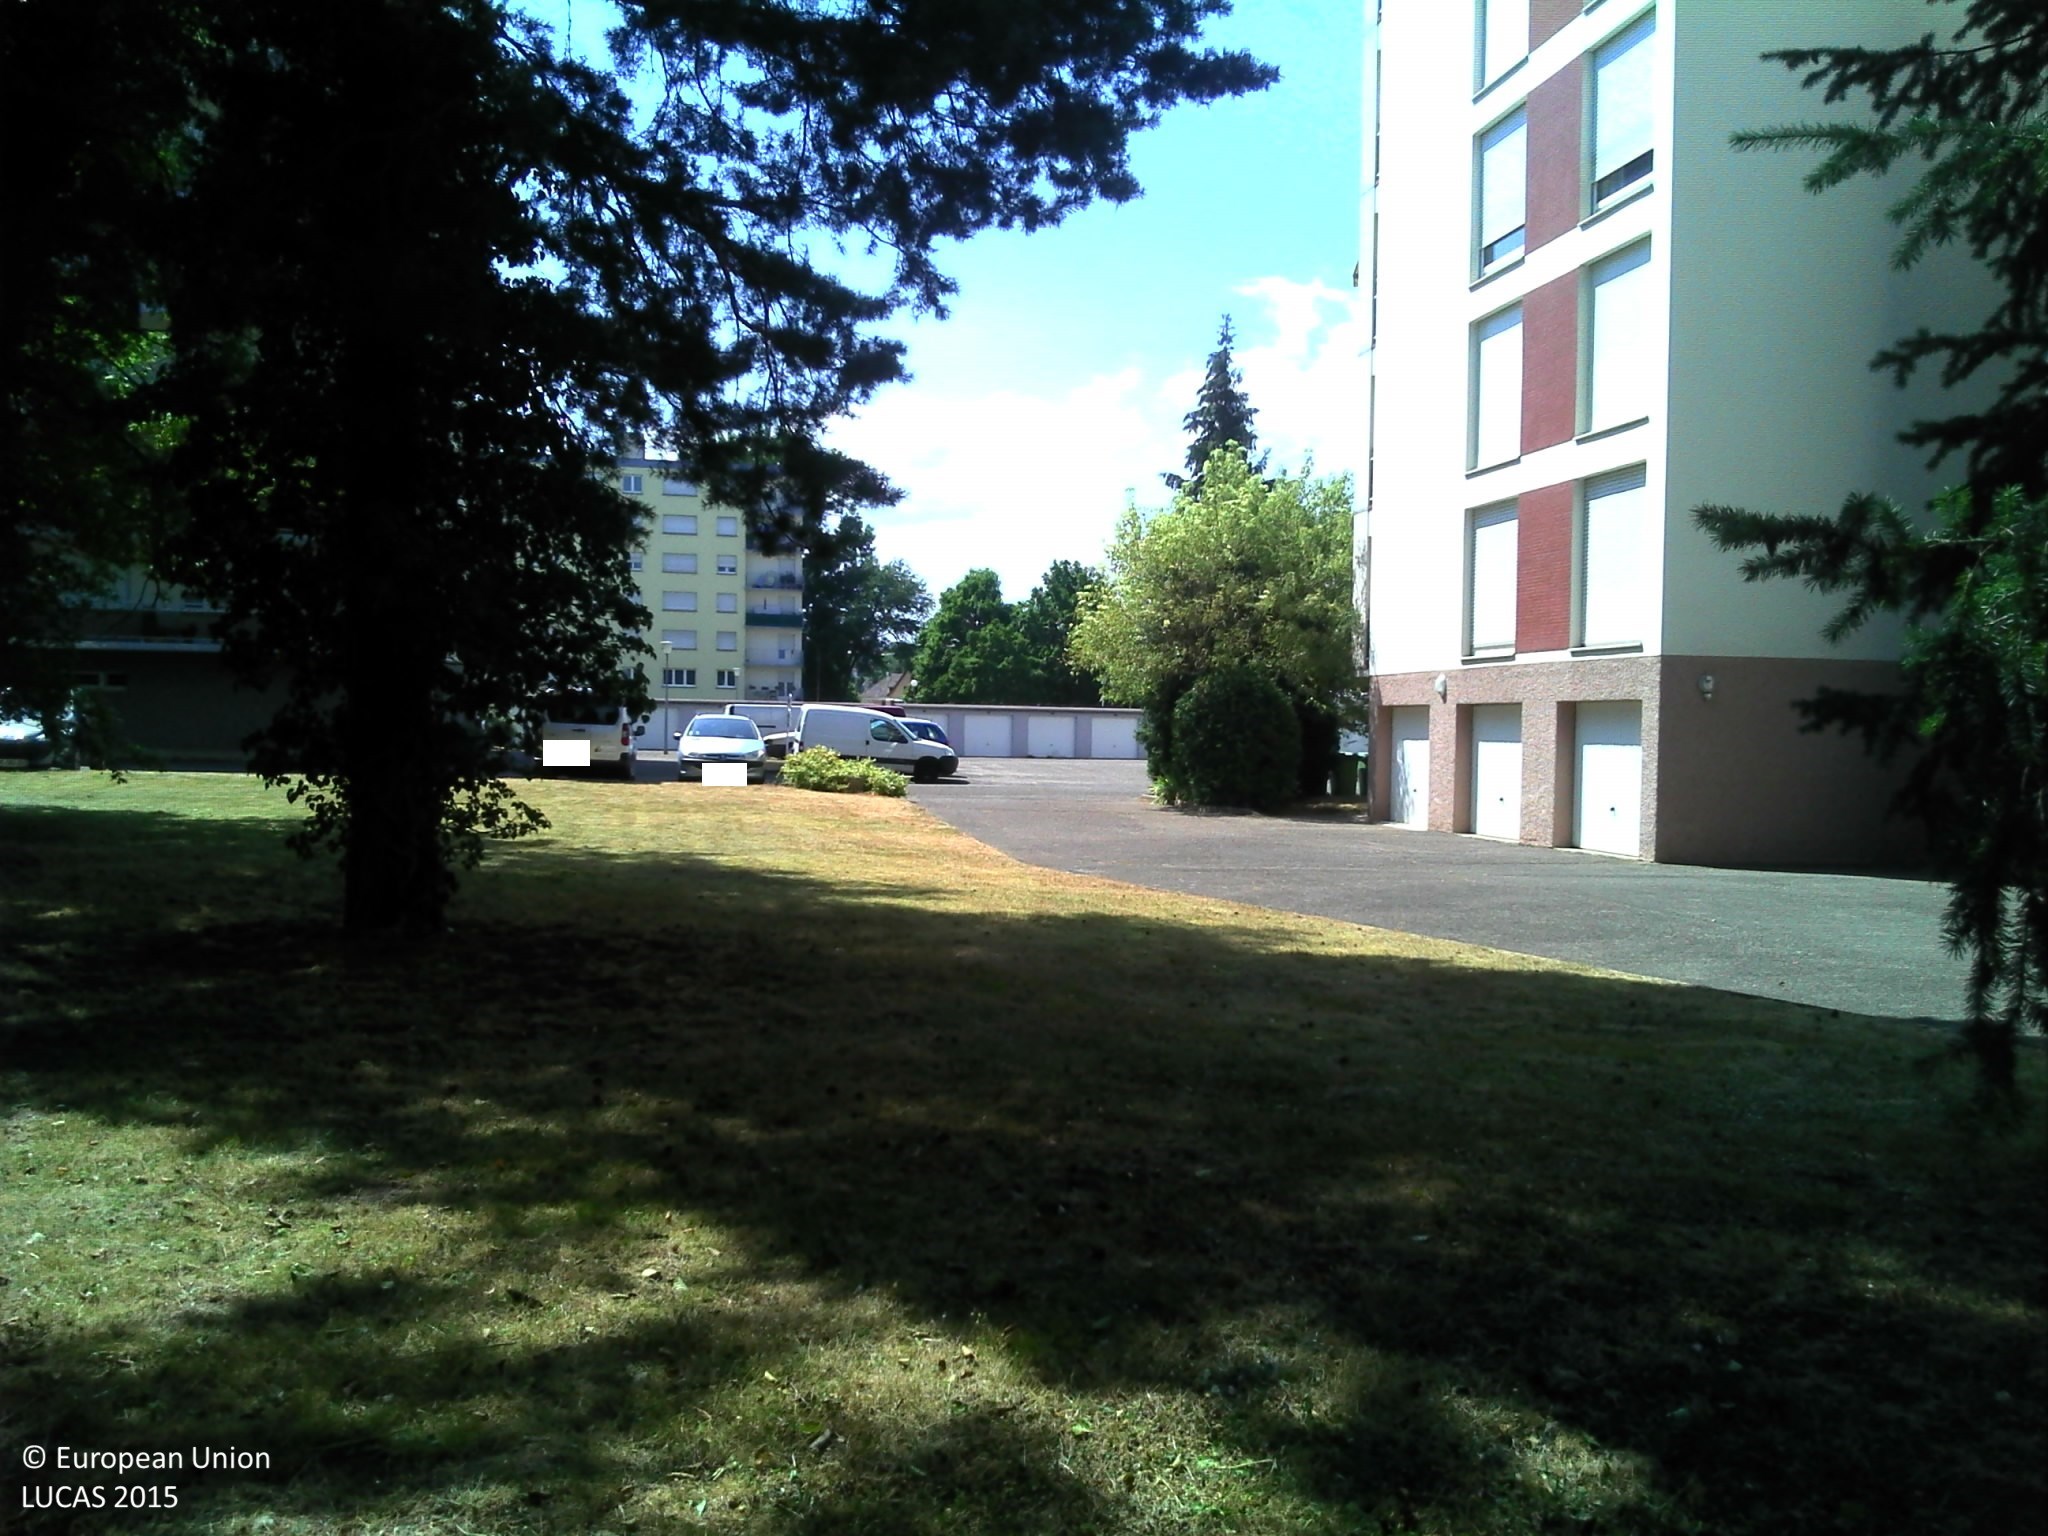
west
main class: Woodland
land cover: Broadleaved woodland
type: floodplain forest
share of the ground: > 75 %
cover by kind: broadleaved forest trees 80 %, herbaceous plants 15 %, coniferous forest trees 5 %
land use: Residential
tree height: > 5 m
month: July
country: FR
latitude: 48.5371
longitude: 7.4953
